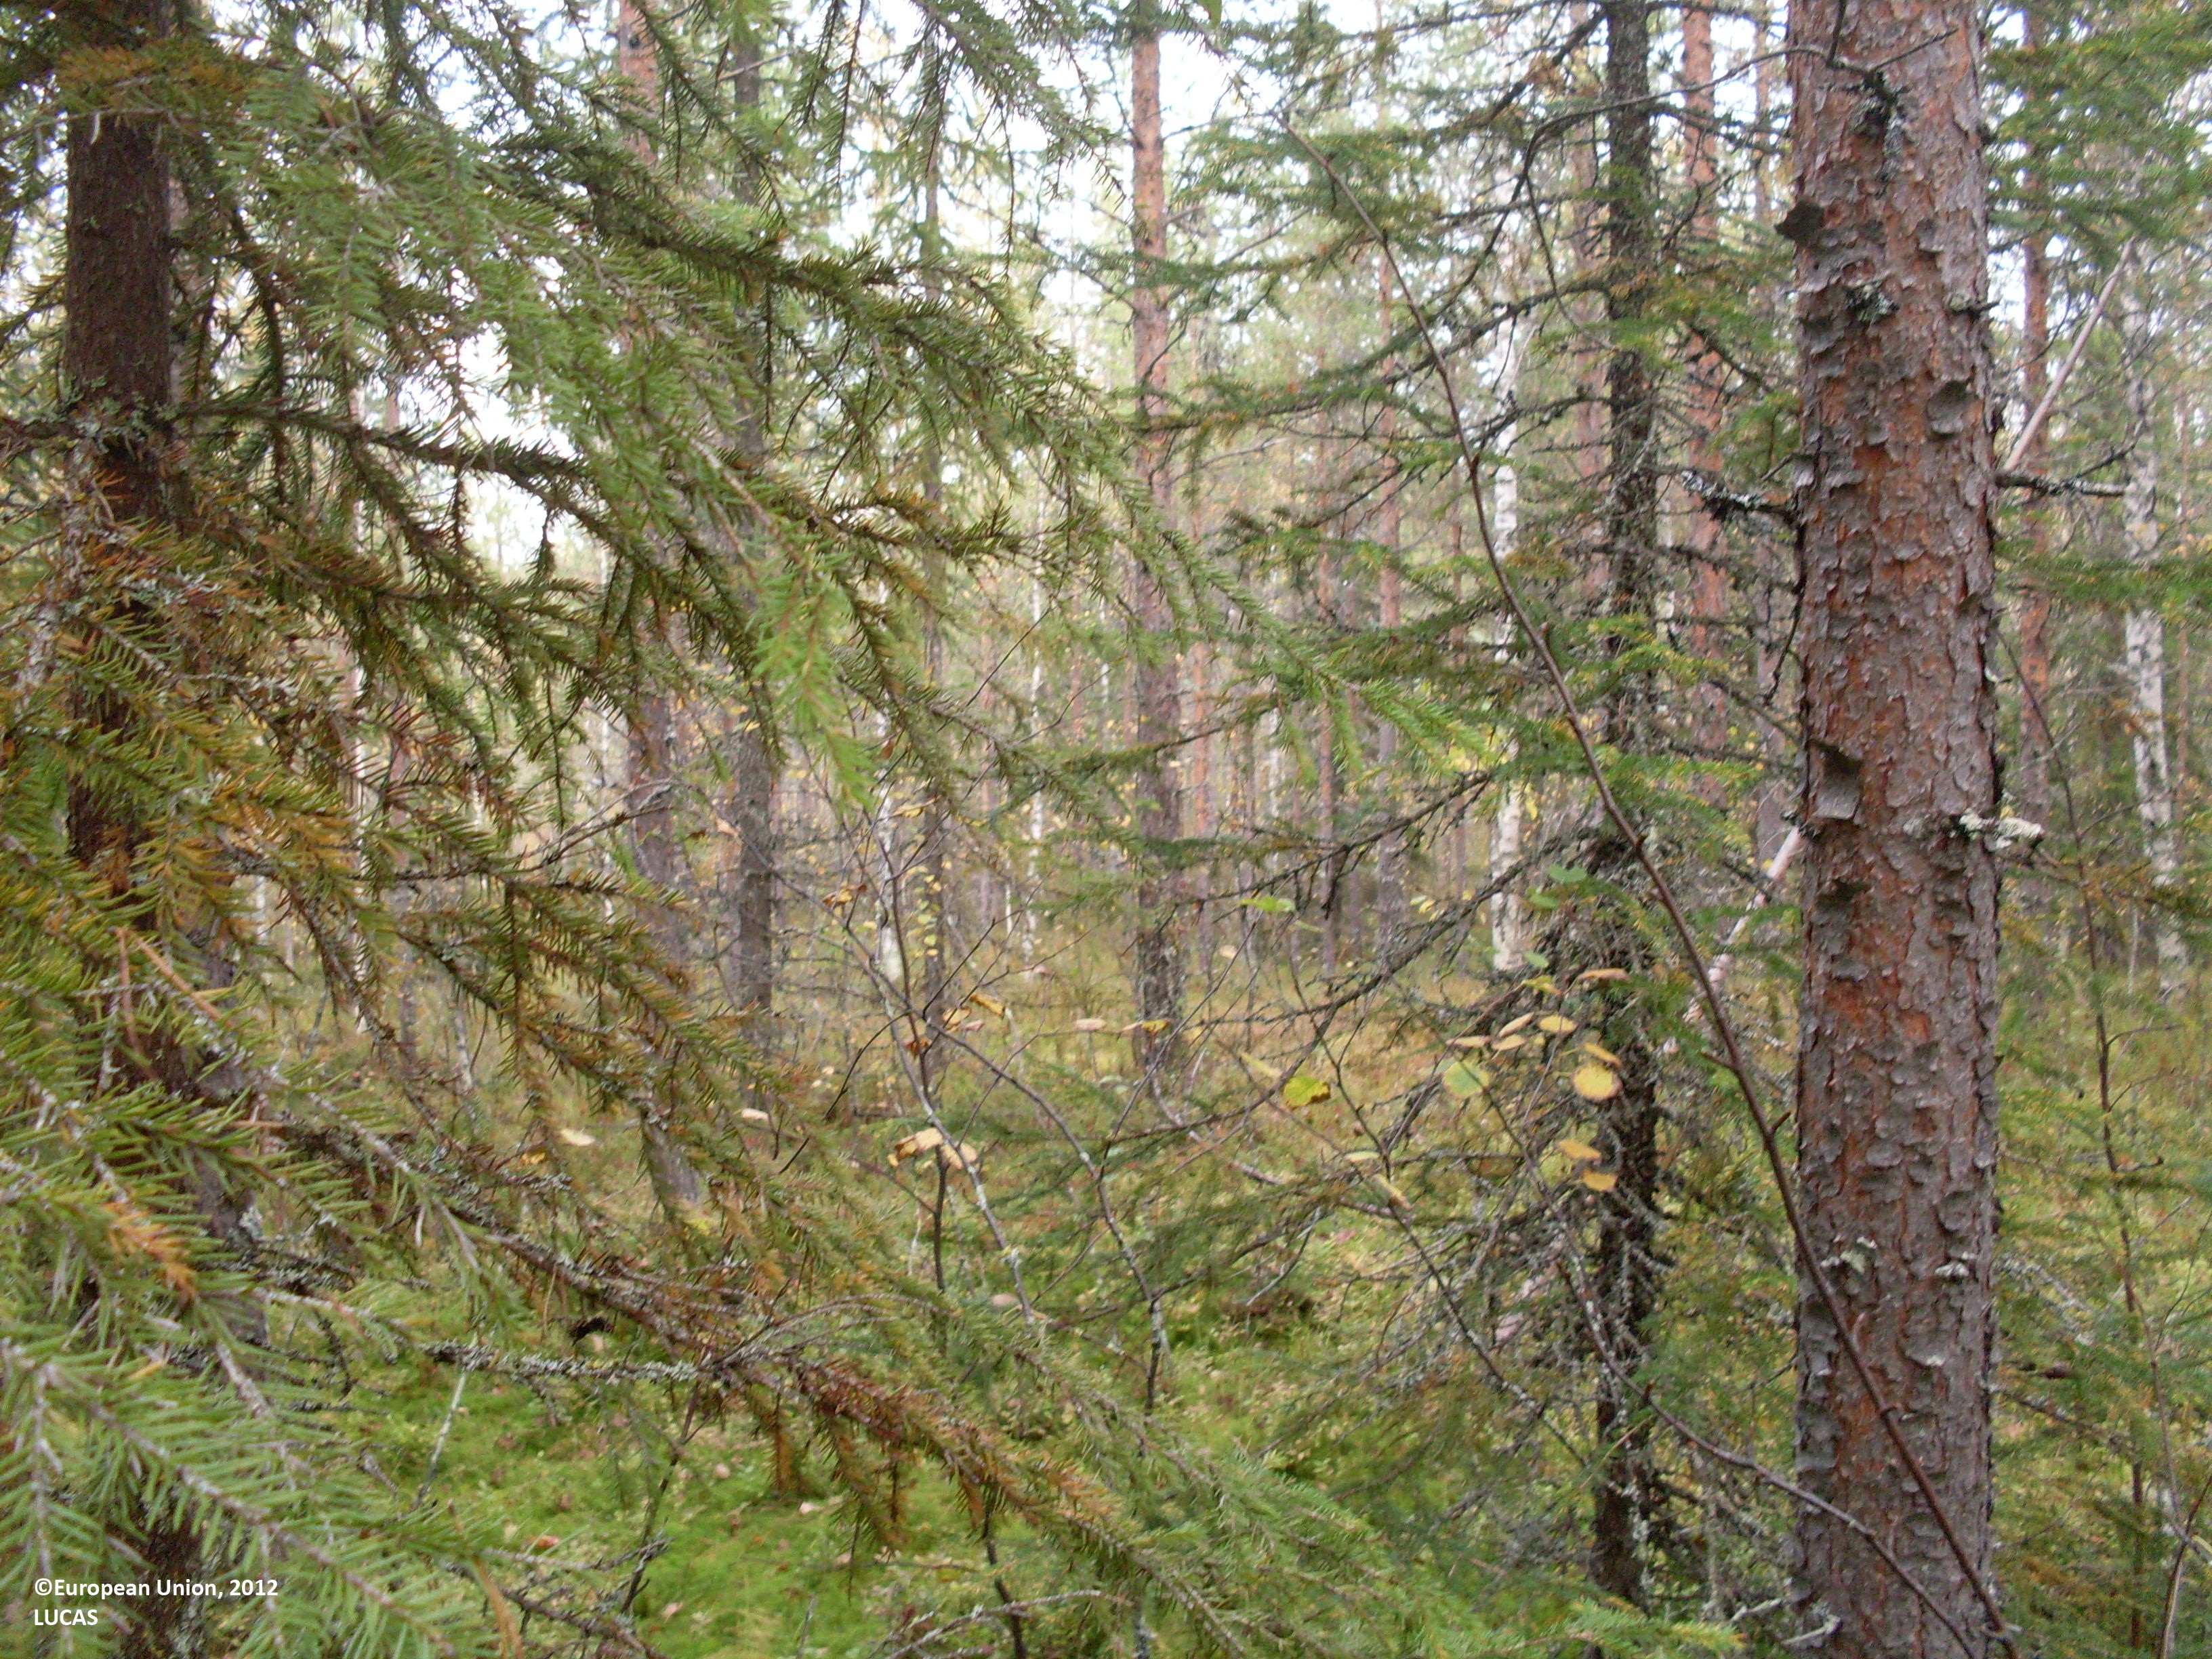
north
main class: Woodland
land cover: Pine dominated coniferous woodland
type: boreal forest
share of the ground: > 75 %
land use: Forestry
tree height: > 5 m
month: September
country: FI
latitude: 64.2655
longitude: 30.2931
